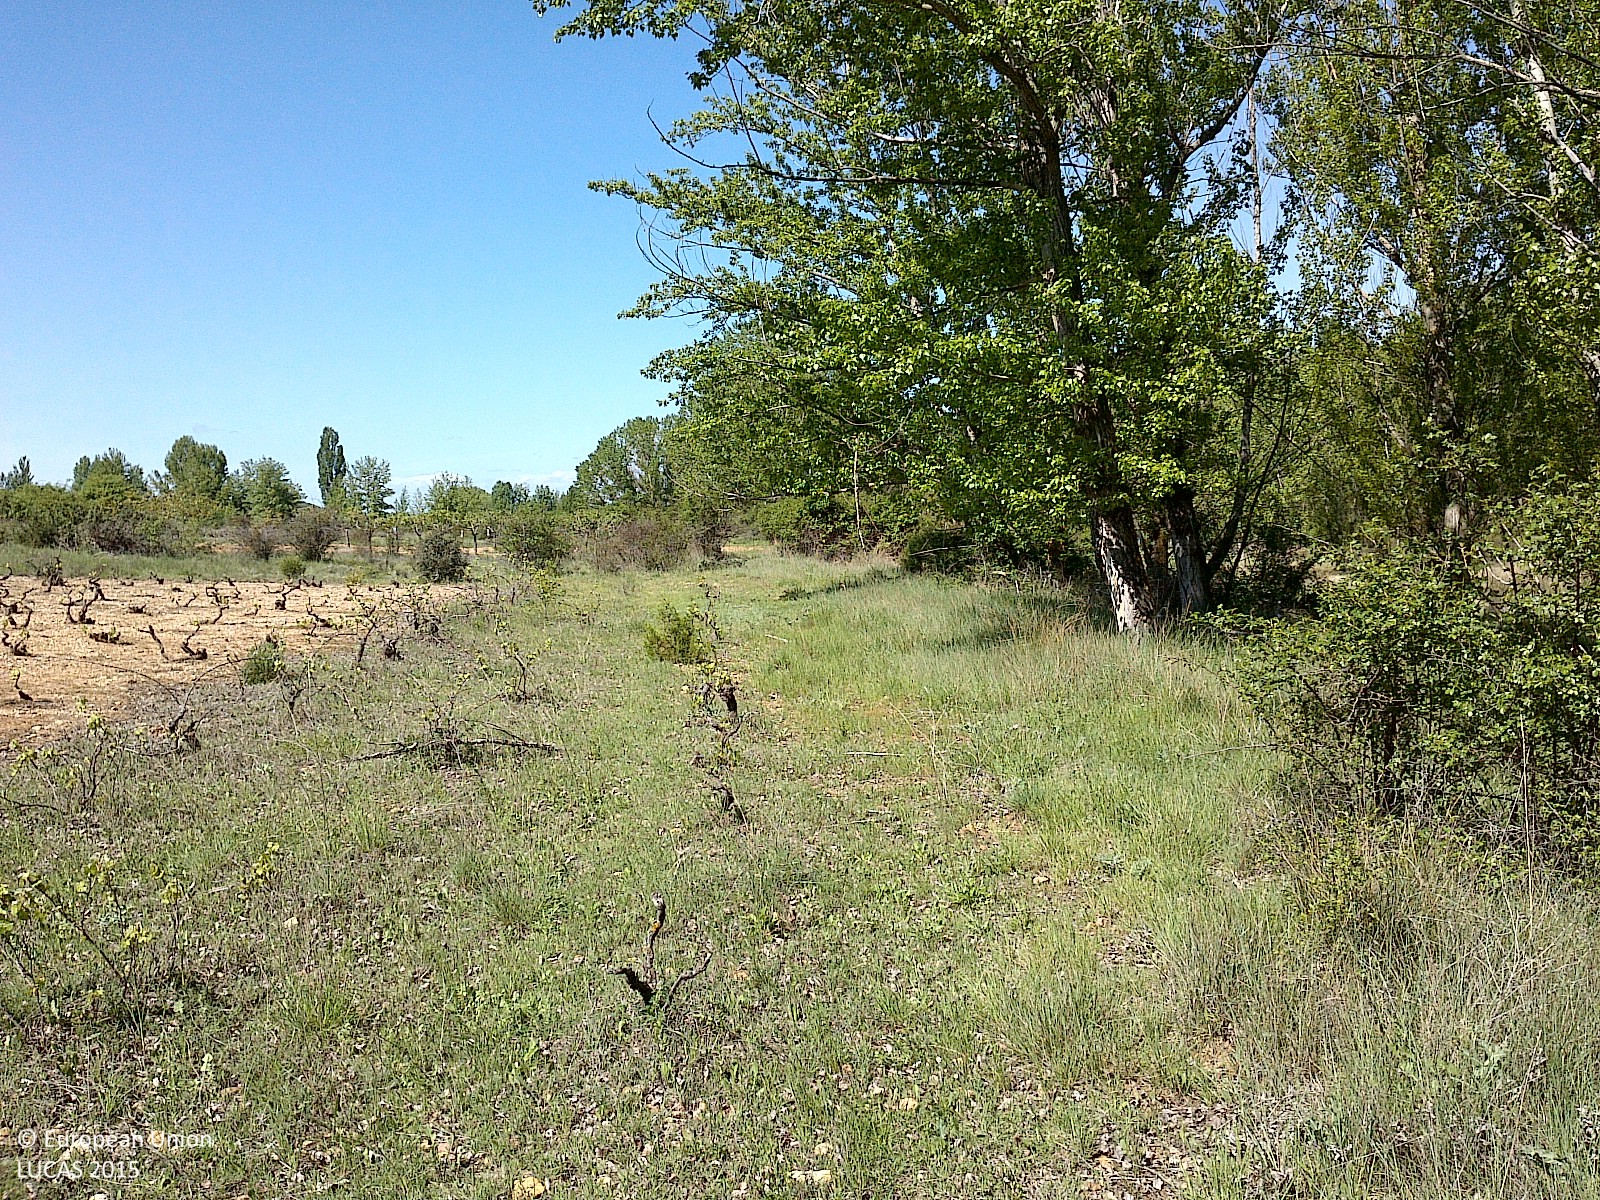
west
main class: Cropland
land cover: Vineyards
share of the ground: < 10 %
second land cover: Spontaneously vegetated surfaces
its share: > 75 %
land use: Abandoned areas
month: May
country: ES
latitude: 41.5875
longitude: -3.1800
